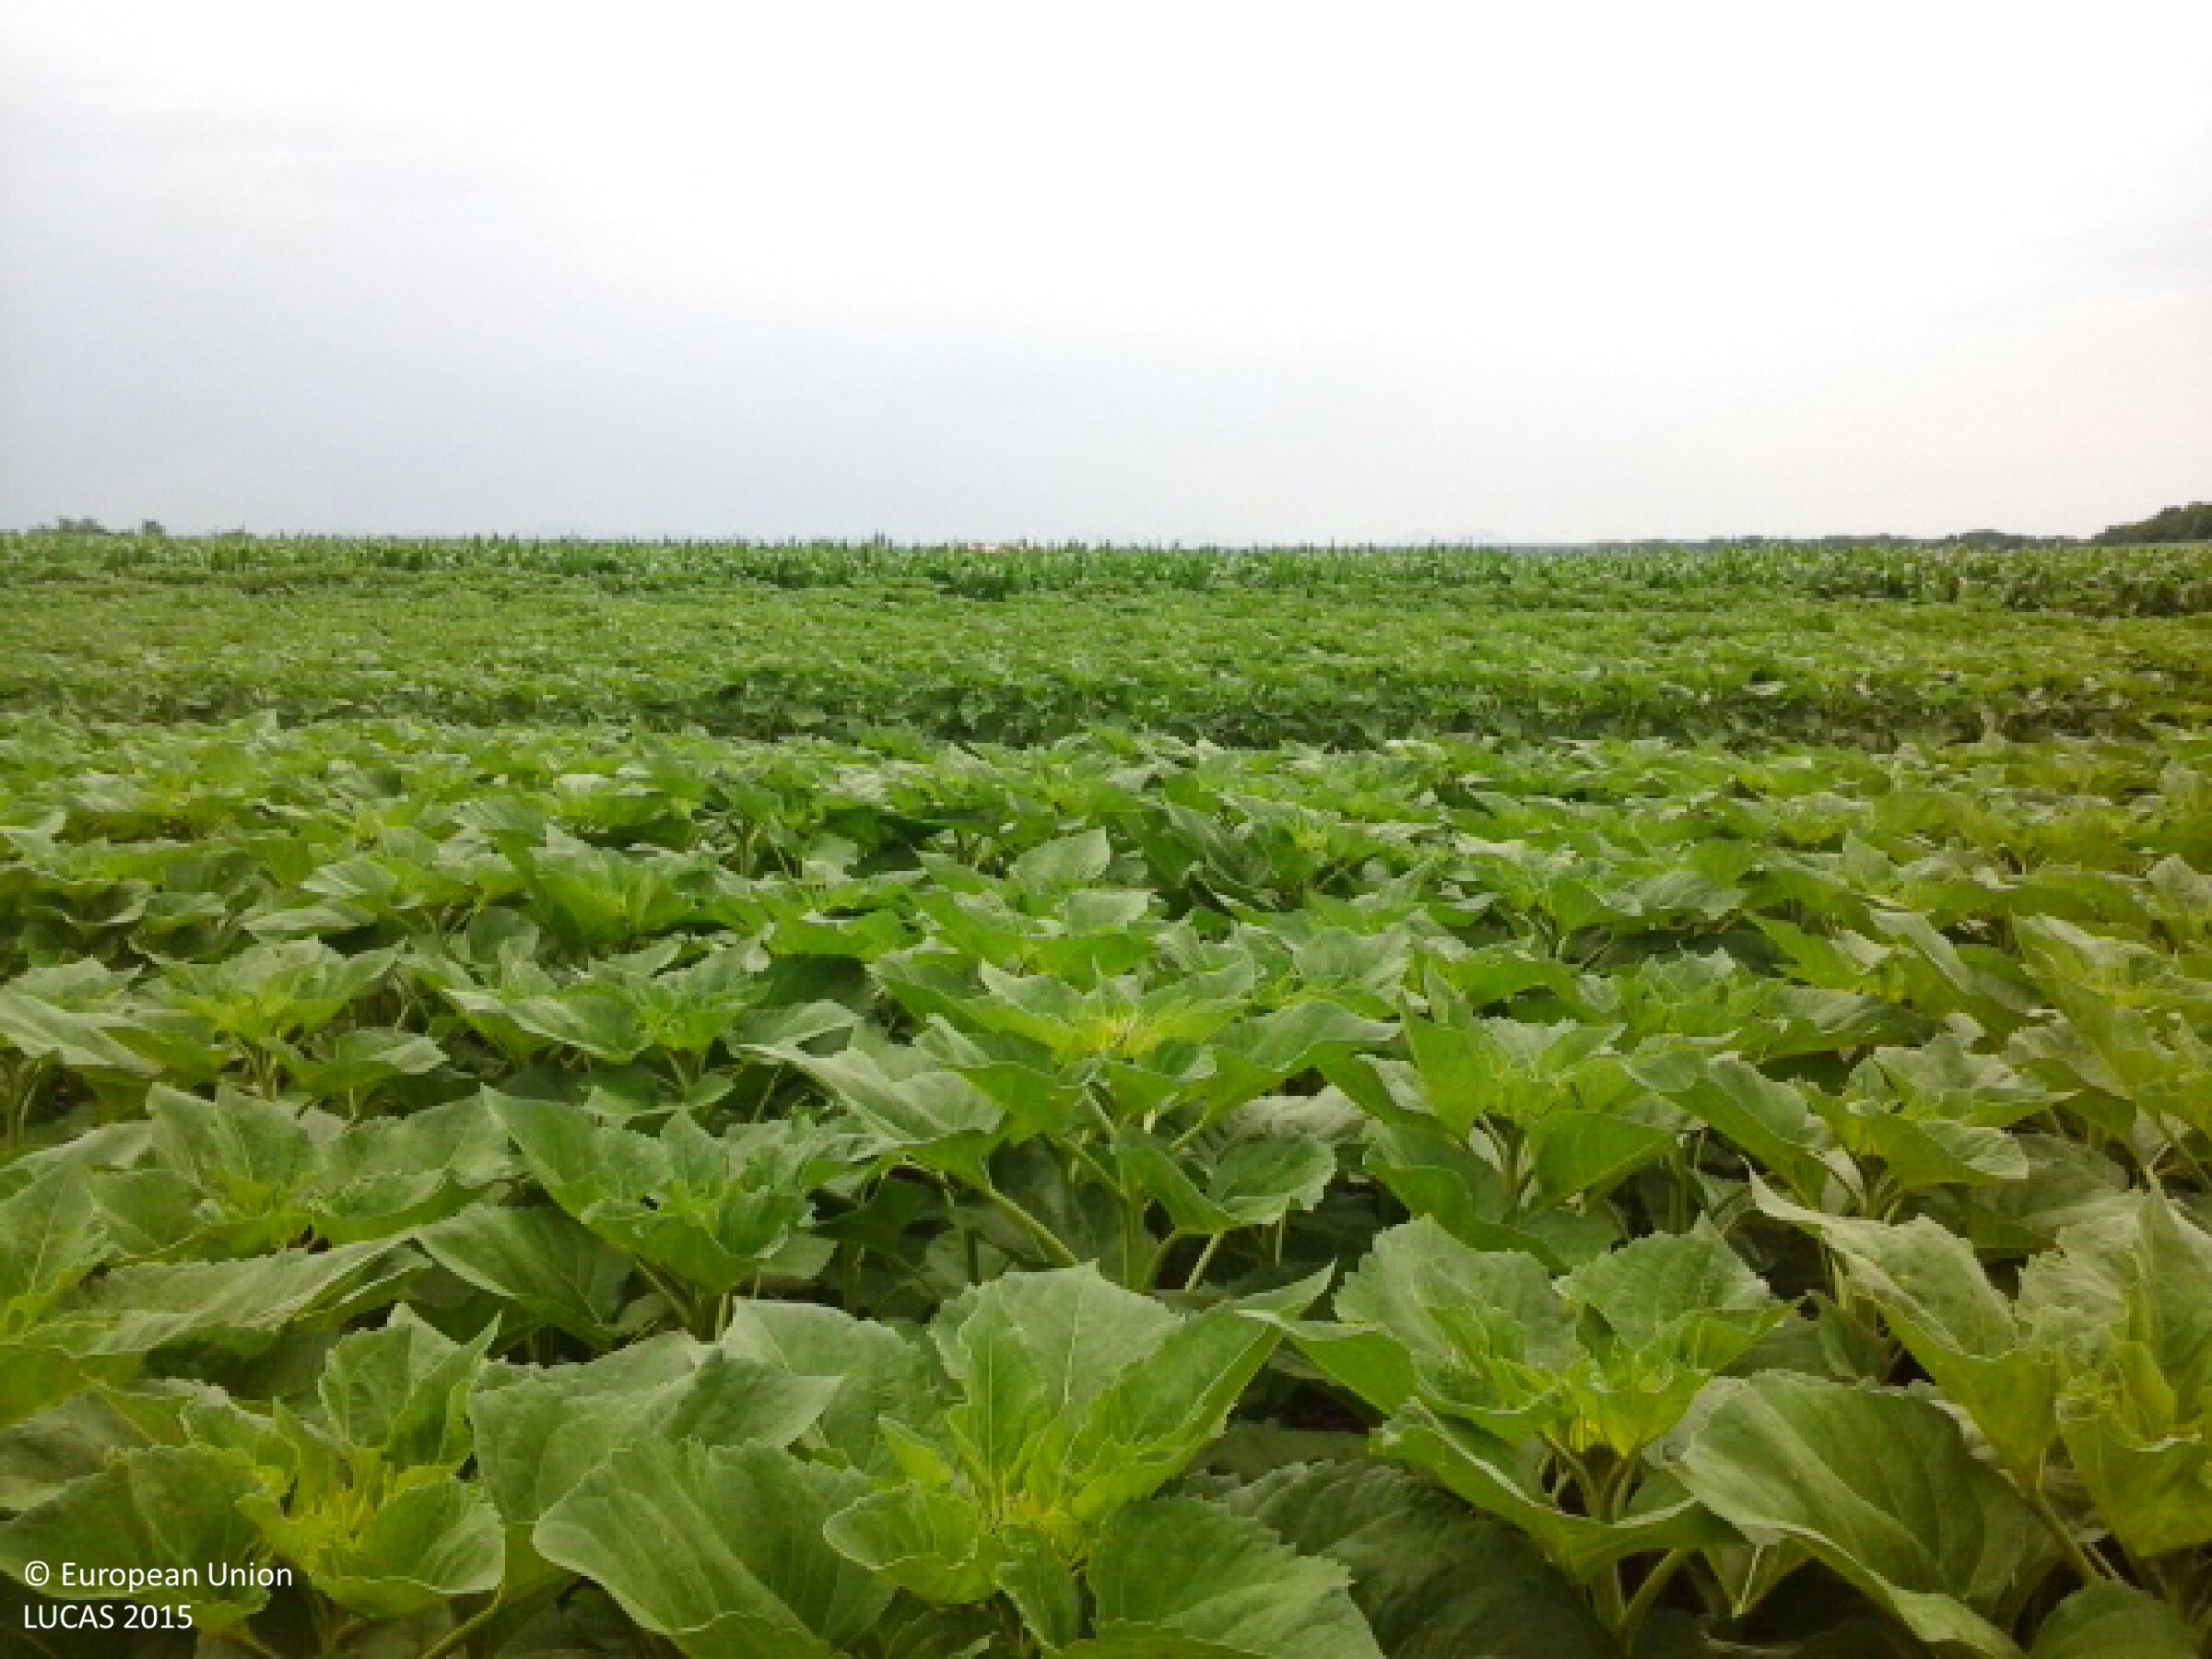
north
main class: Cropland
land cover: Sunflower
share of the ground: > 75 %
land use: Agriculture (excluding fallow land and kitchen gardens)
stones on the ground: < 10 %
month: June
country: HU
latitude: 48.1398
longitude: 21.5637
